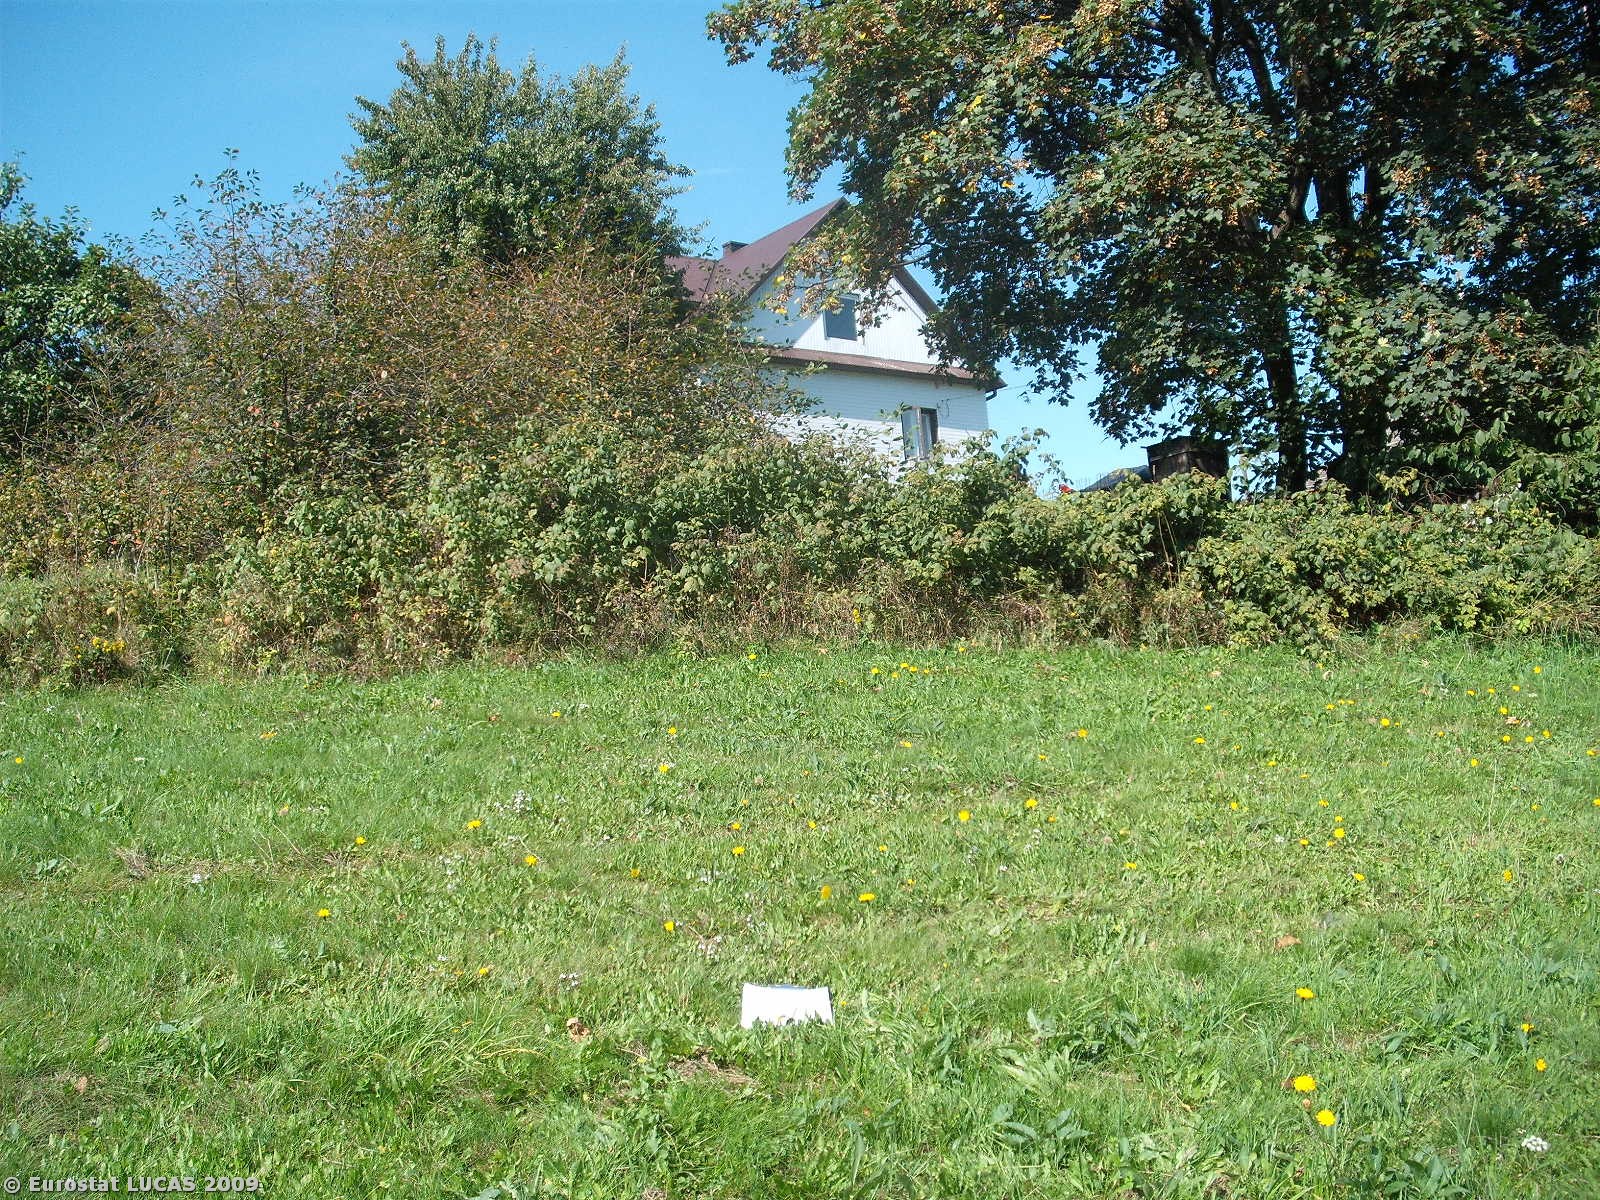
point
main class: Grassland
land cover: Grassland without tree/shrub cover
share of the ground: > 75 %
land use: Agriculture (excluding fallow land and kitchen gardens)
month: September
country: PL
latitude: 49.7102
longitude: 20.5635
